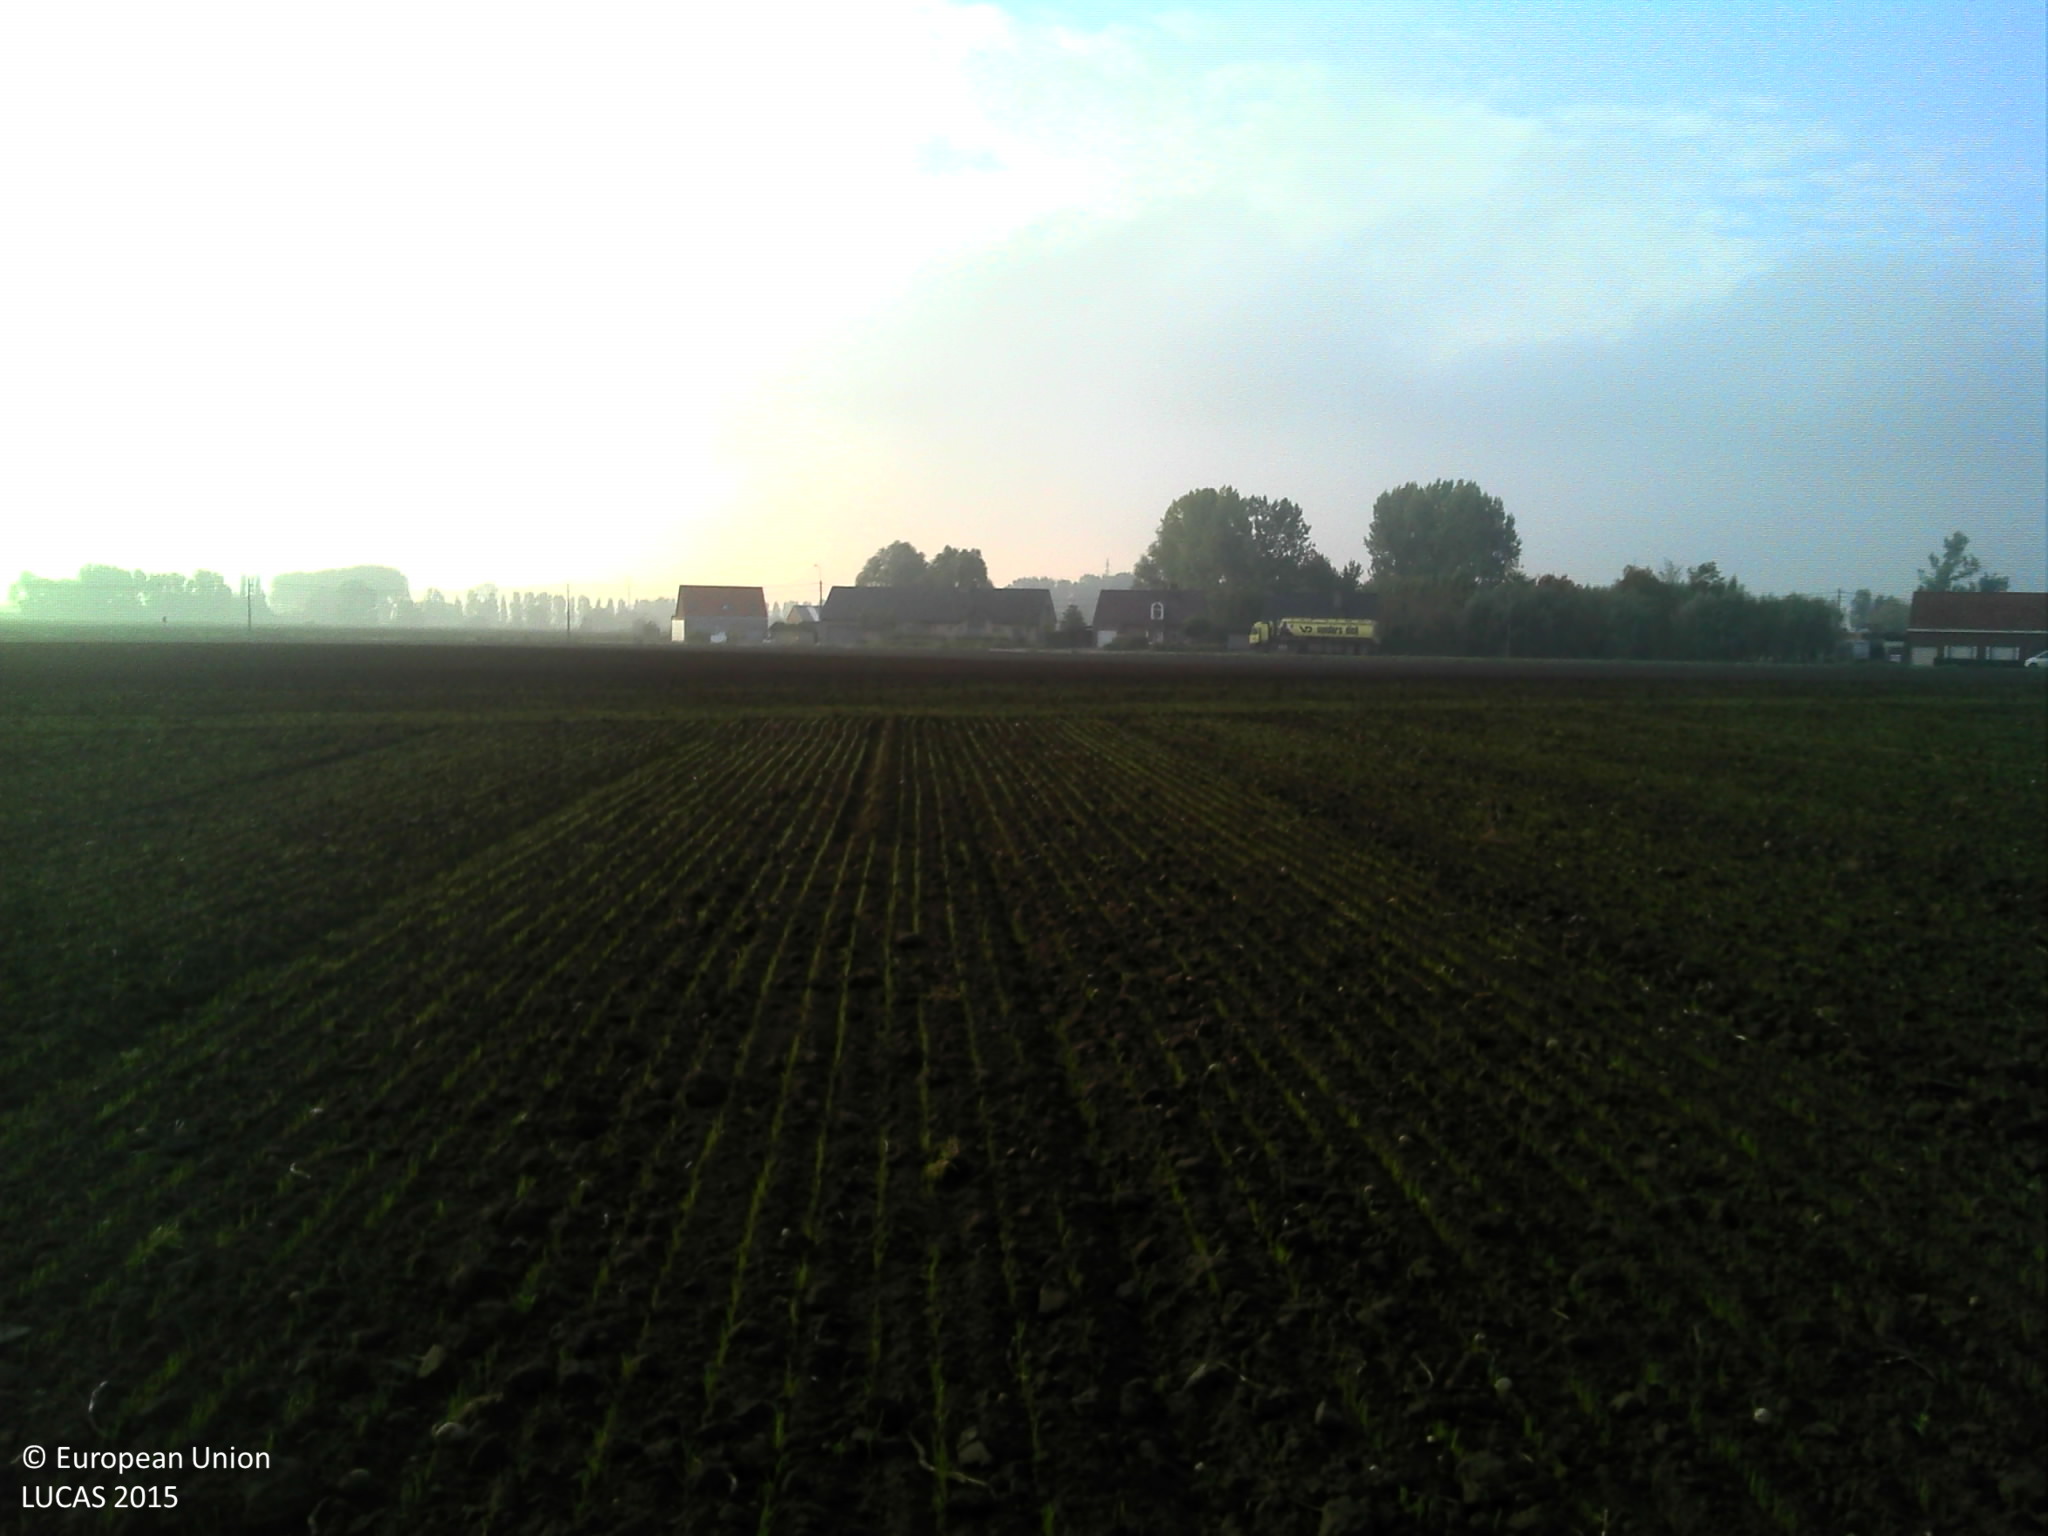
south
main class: Cropland
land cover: Temporary grasslands
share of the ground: < 10 %
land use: Agriculture (excluding fallow land and kitchen gardens)
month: October
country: BE
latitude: 50.9403
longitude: 2.9451
